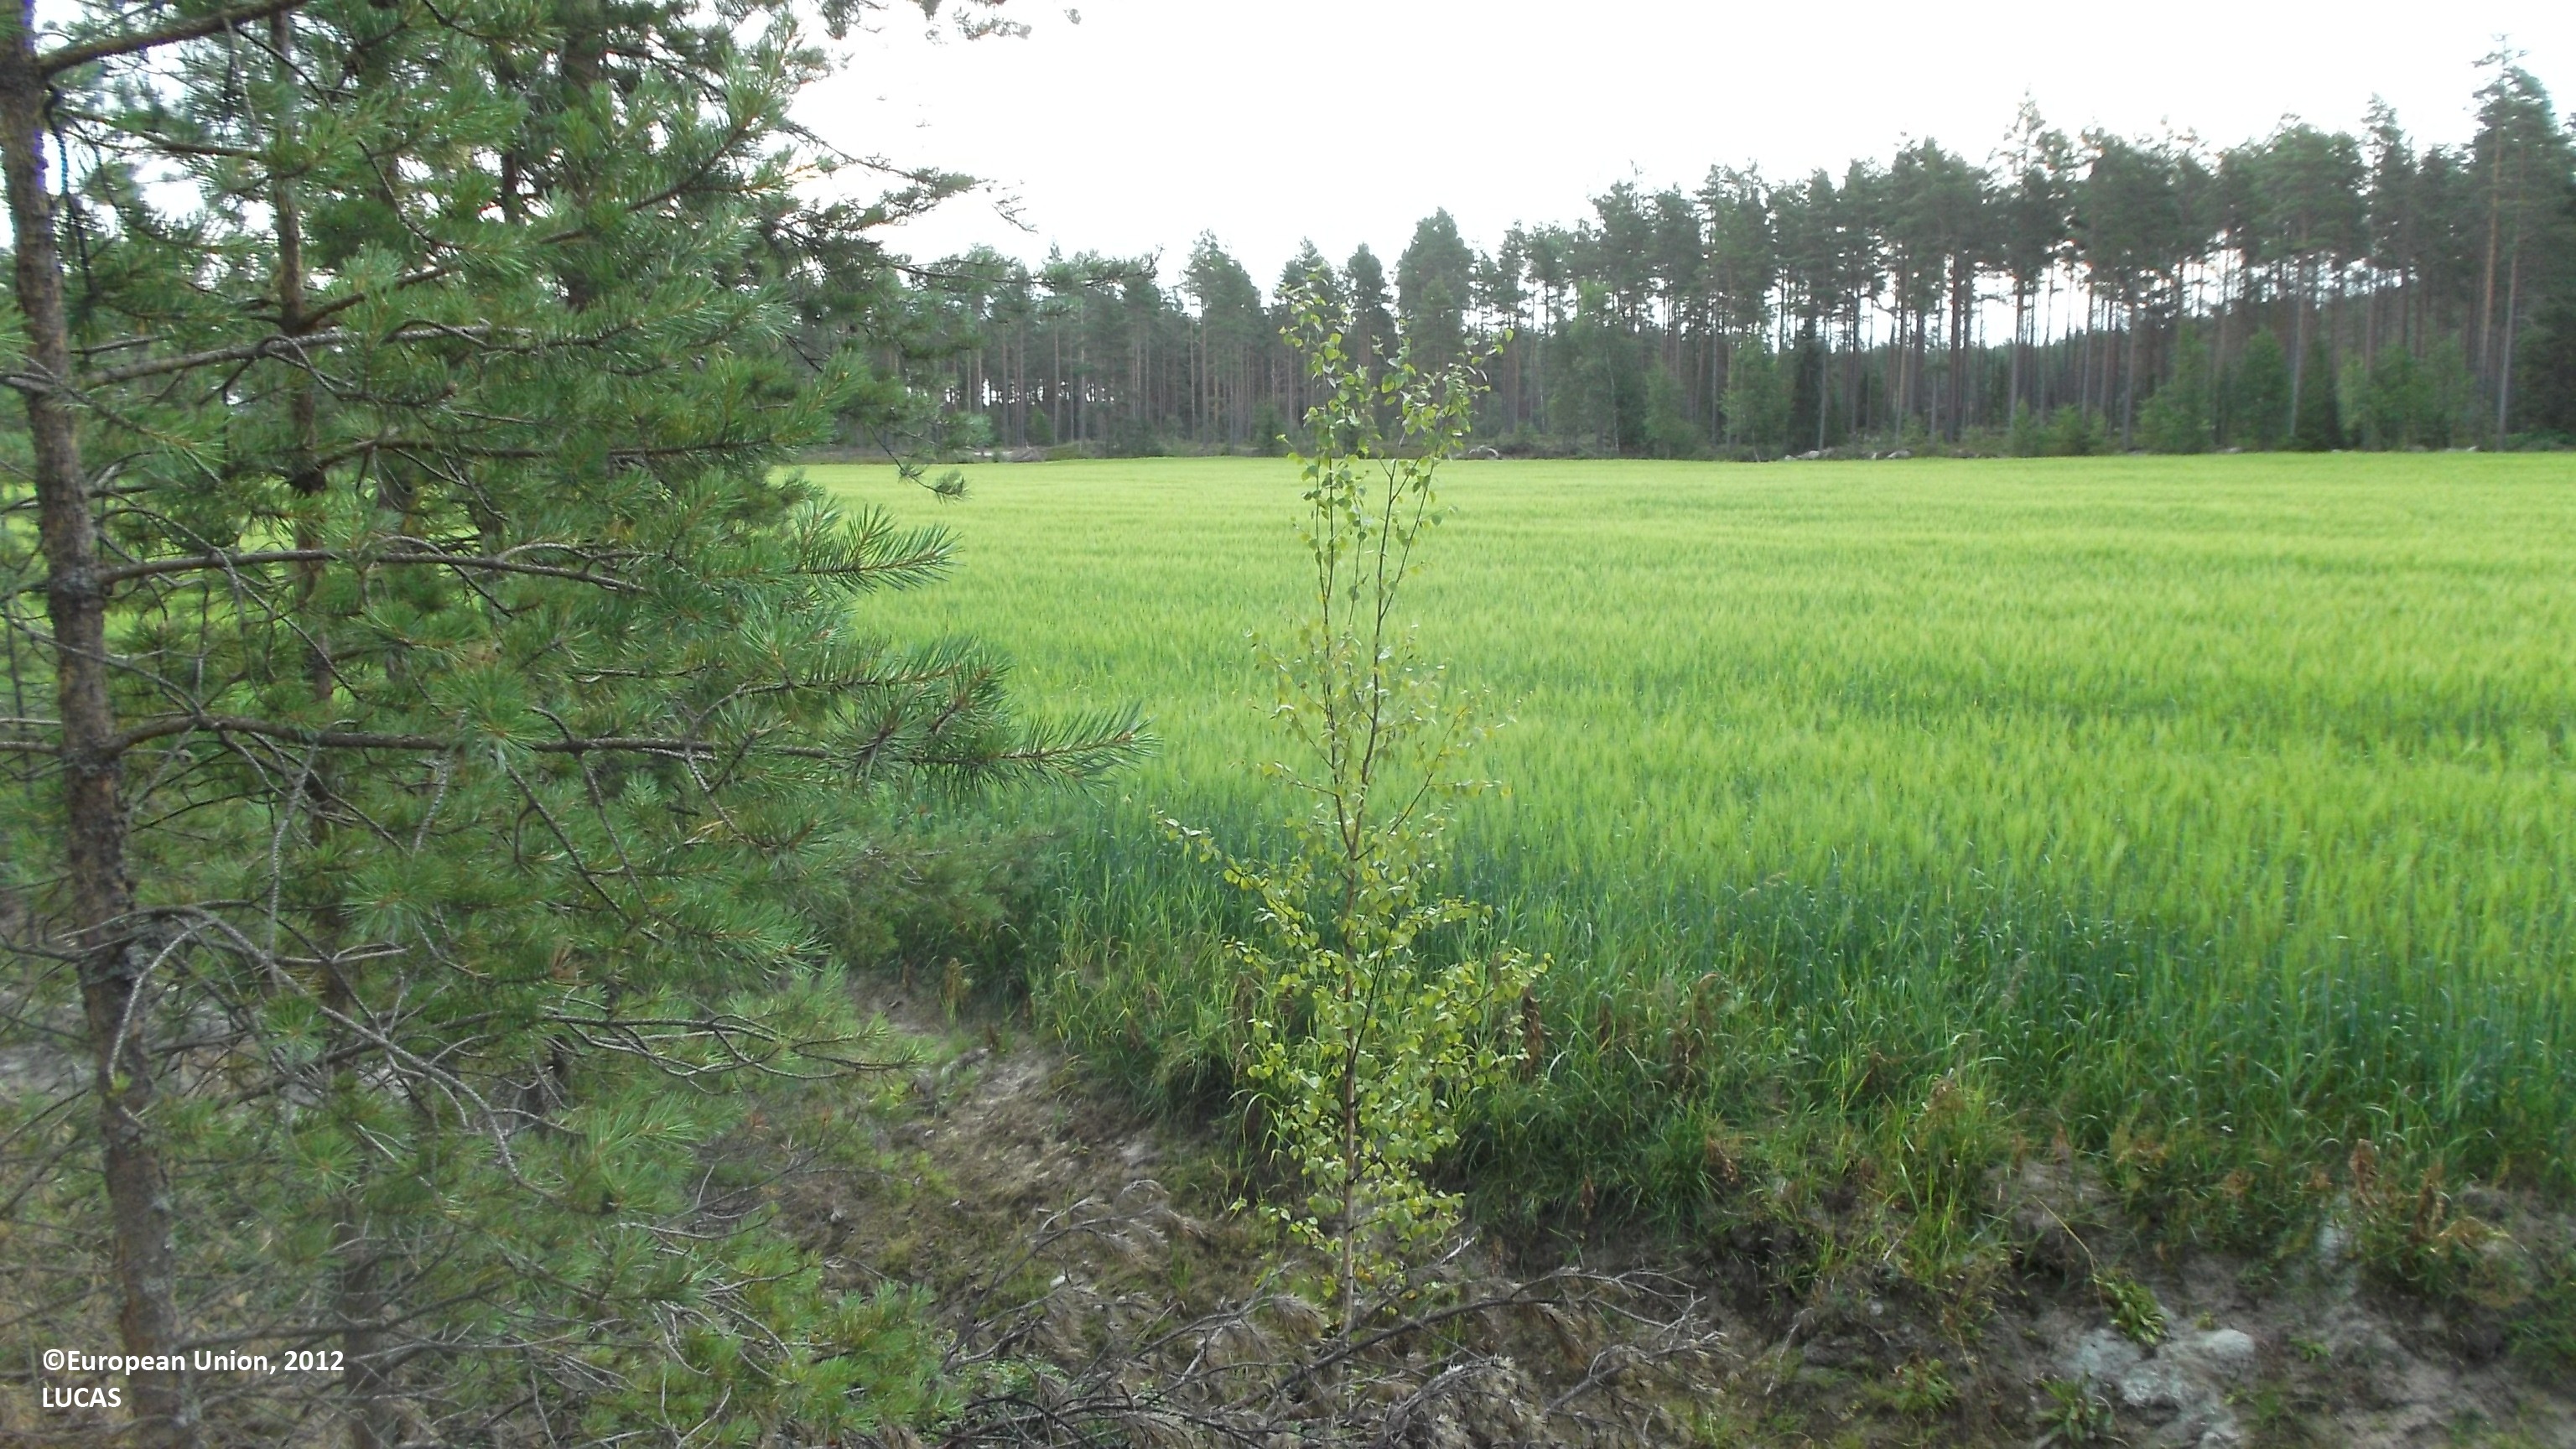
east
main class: Woodland
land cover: Pine dominated coniferous woodland
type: boreal forest
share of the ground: 10 - 25 %
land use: Forestry
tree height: > 5 m
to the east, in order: Pine dominated coniferous woodland; Ditches and canals; Barley; Pine dominated coniferous woodland; Tracks; Pine dominated coniferous woodland
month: July
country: FI
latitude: 63.9707
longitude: 23.4343
